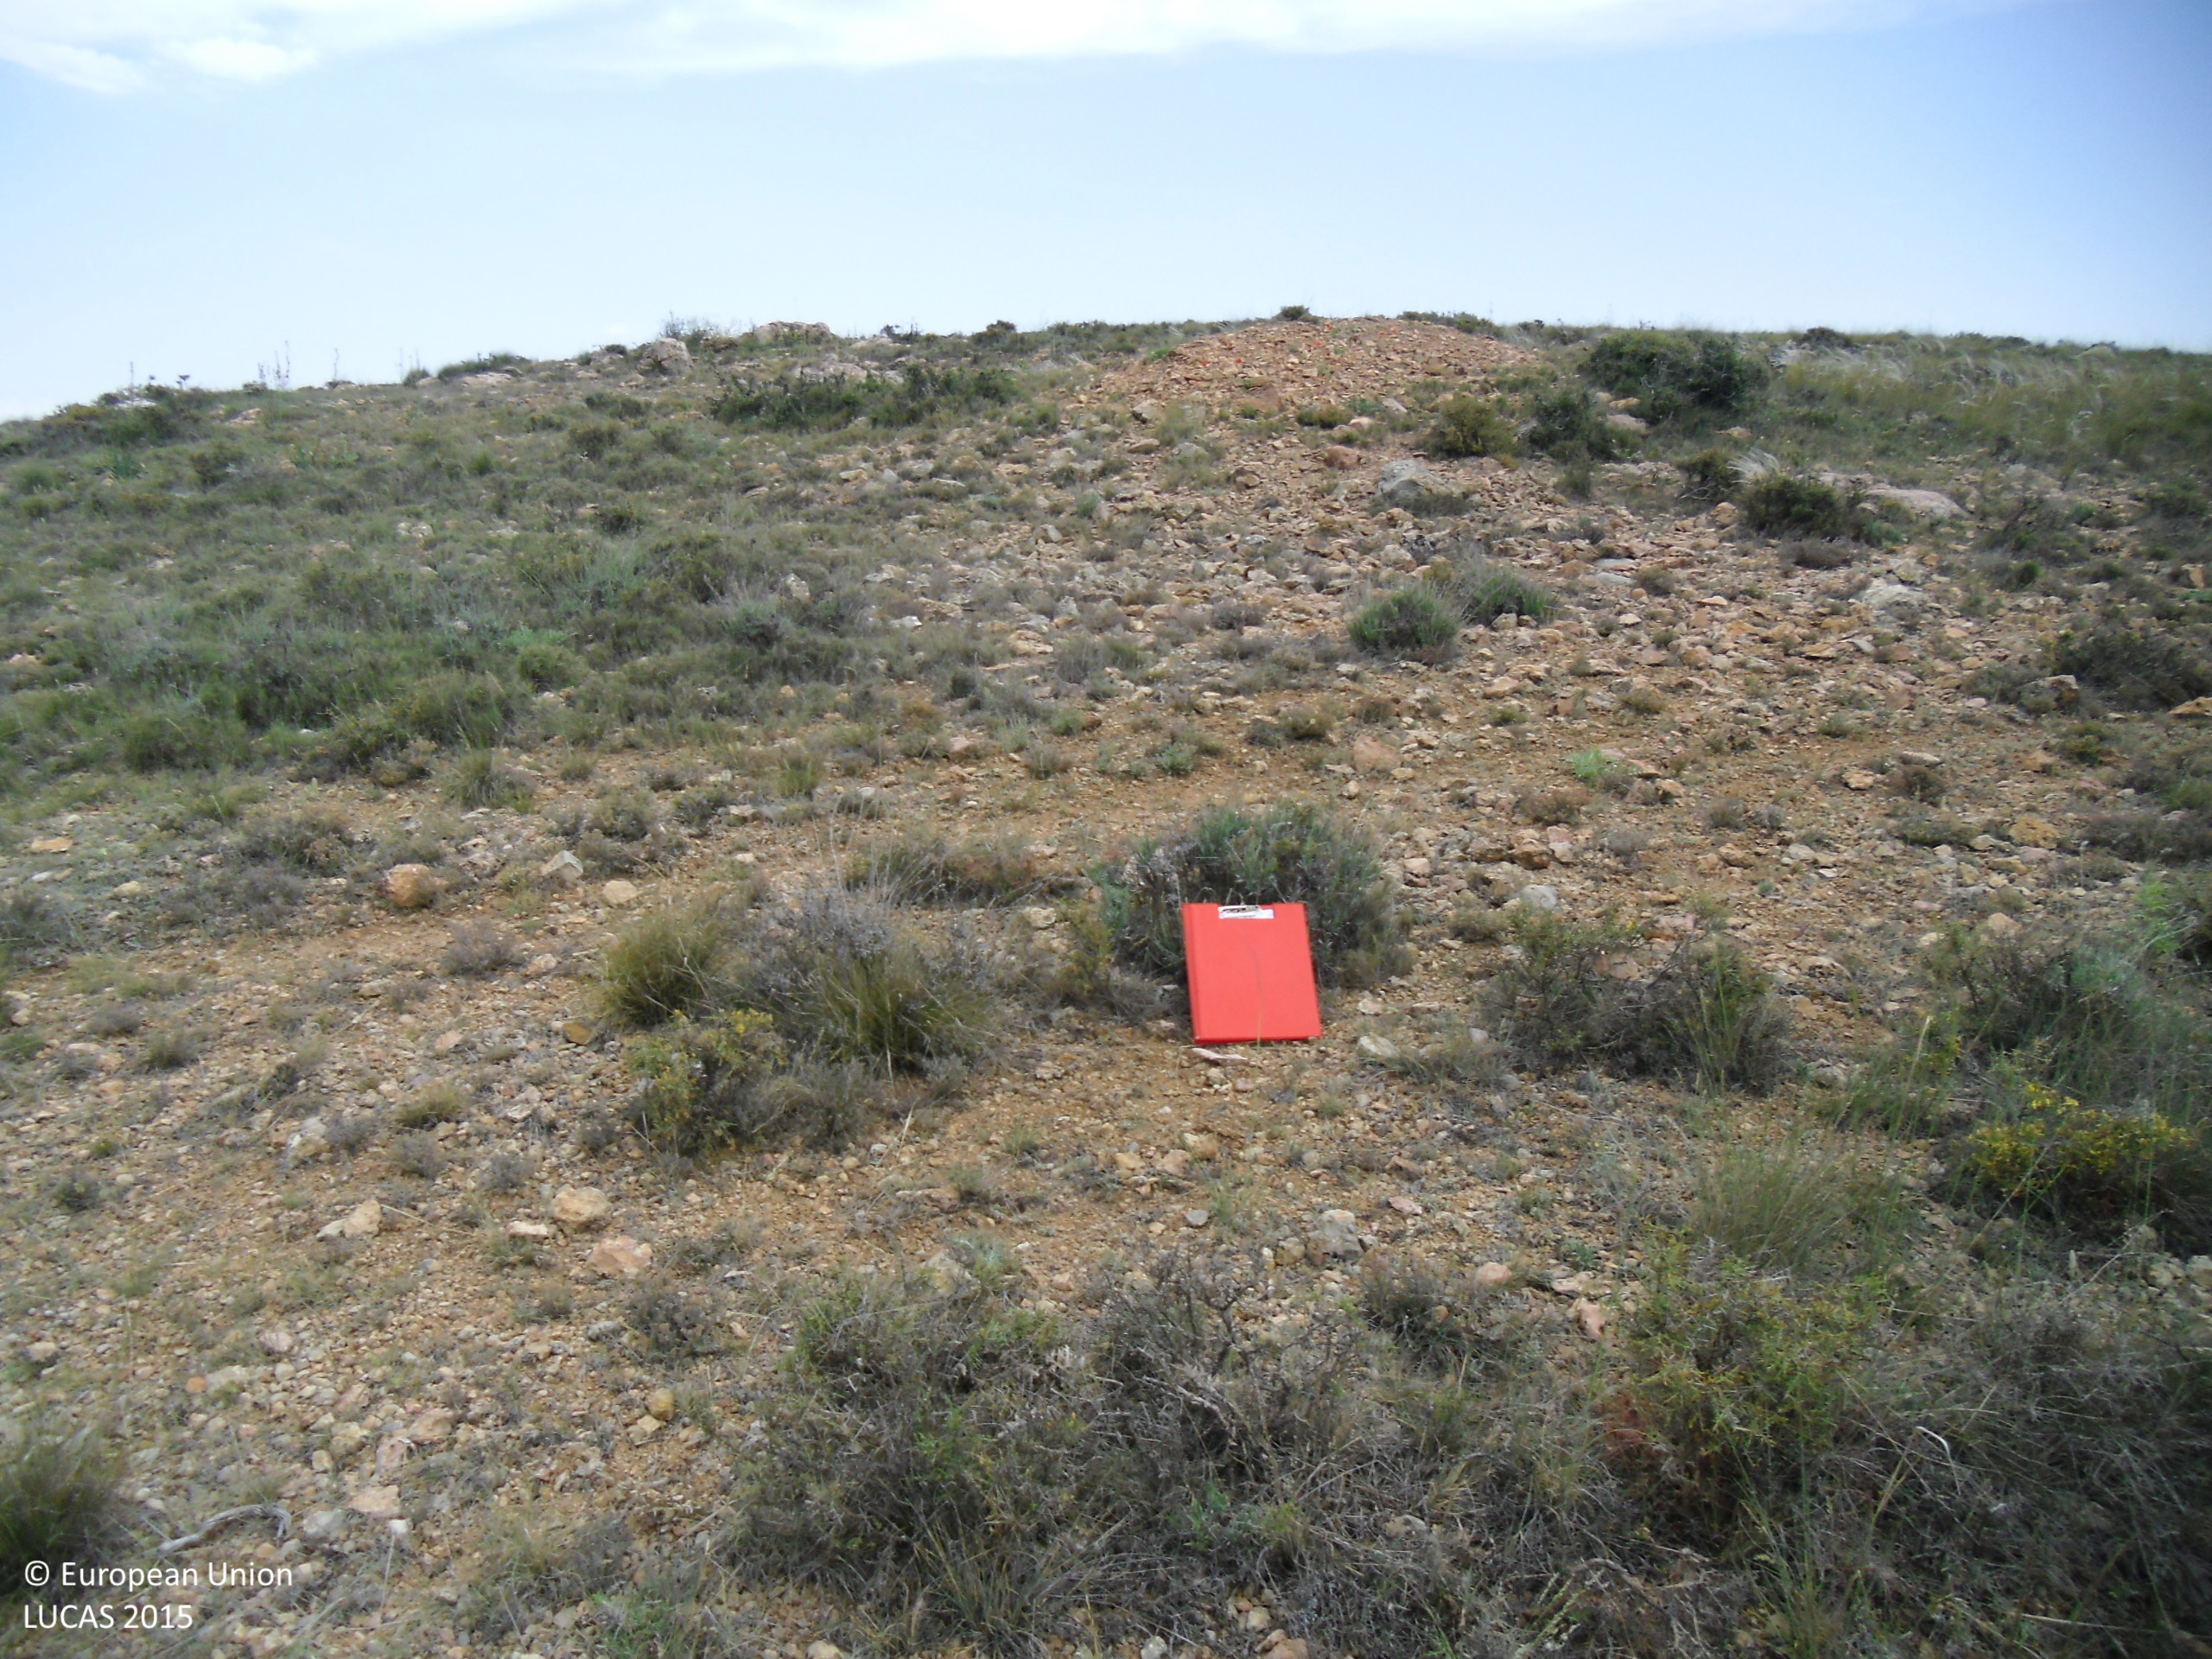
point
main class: Shrubland
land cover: Shrubland without tree cover
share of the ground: 10 - 25 %
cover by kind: consolidated bare surface 60 %, shrubs 20 %, herbaceous plants 20 %
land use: Agriculture (excluding fallow land and kitchen gardens)
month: May
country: ES
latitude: 40.9723
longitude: -0.8888
